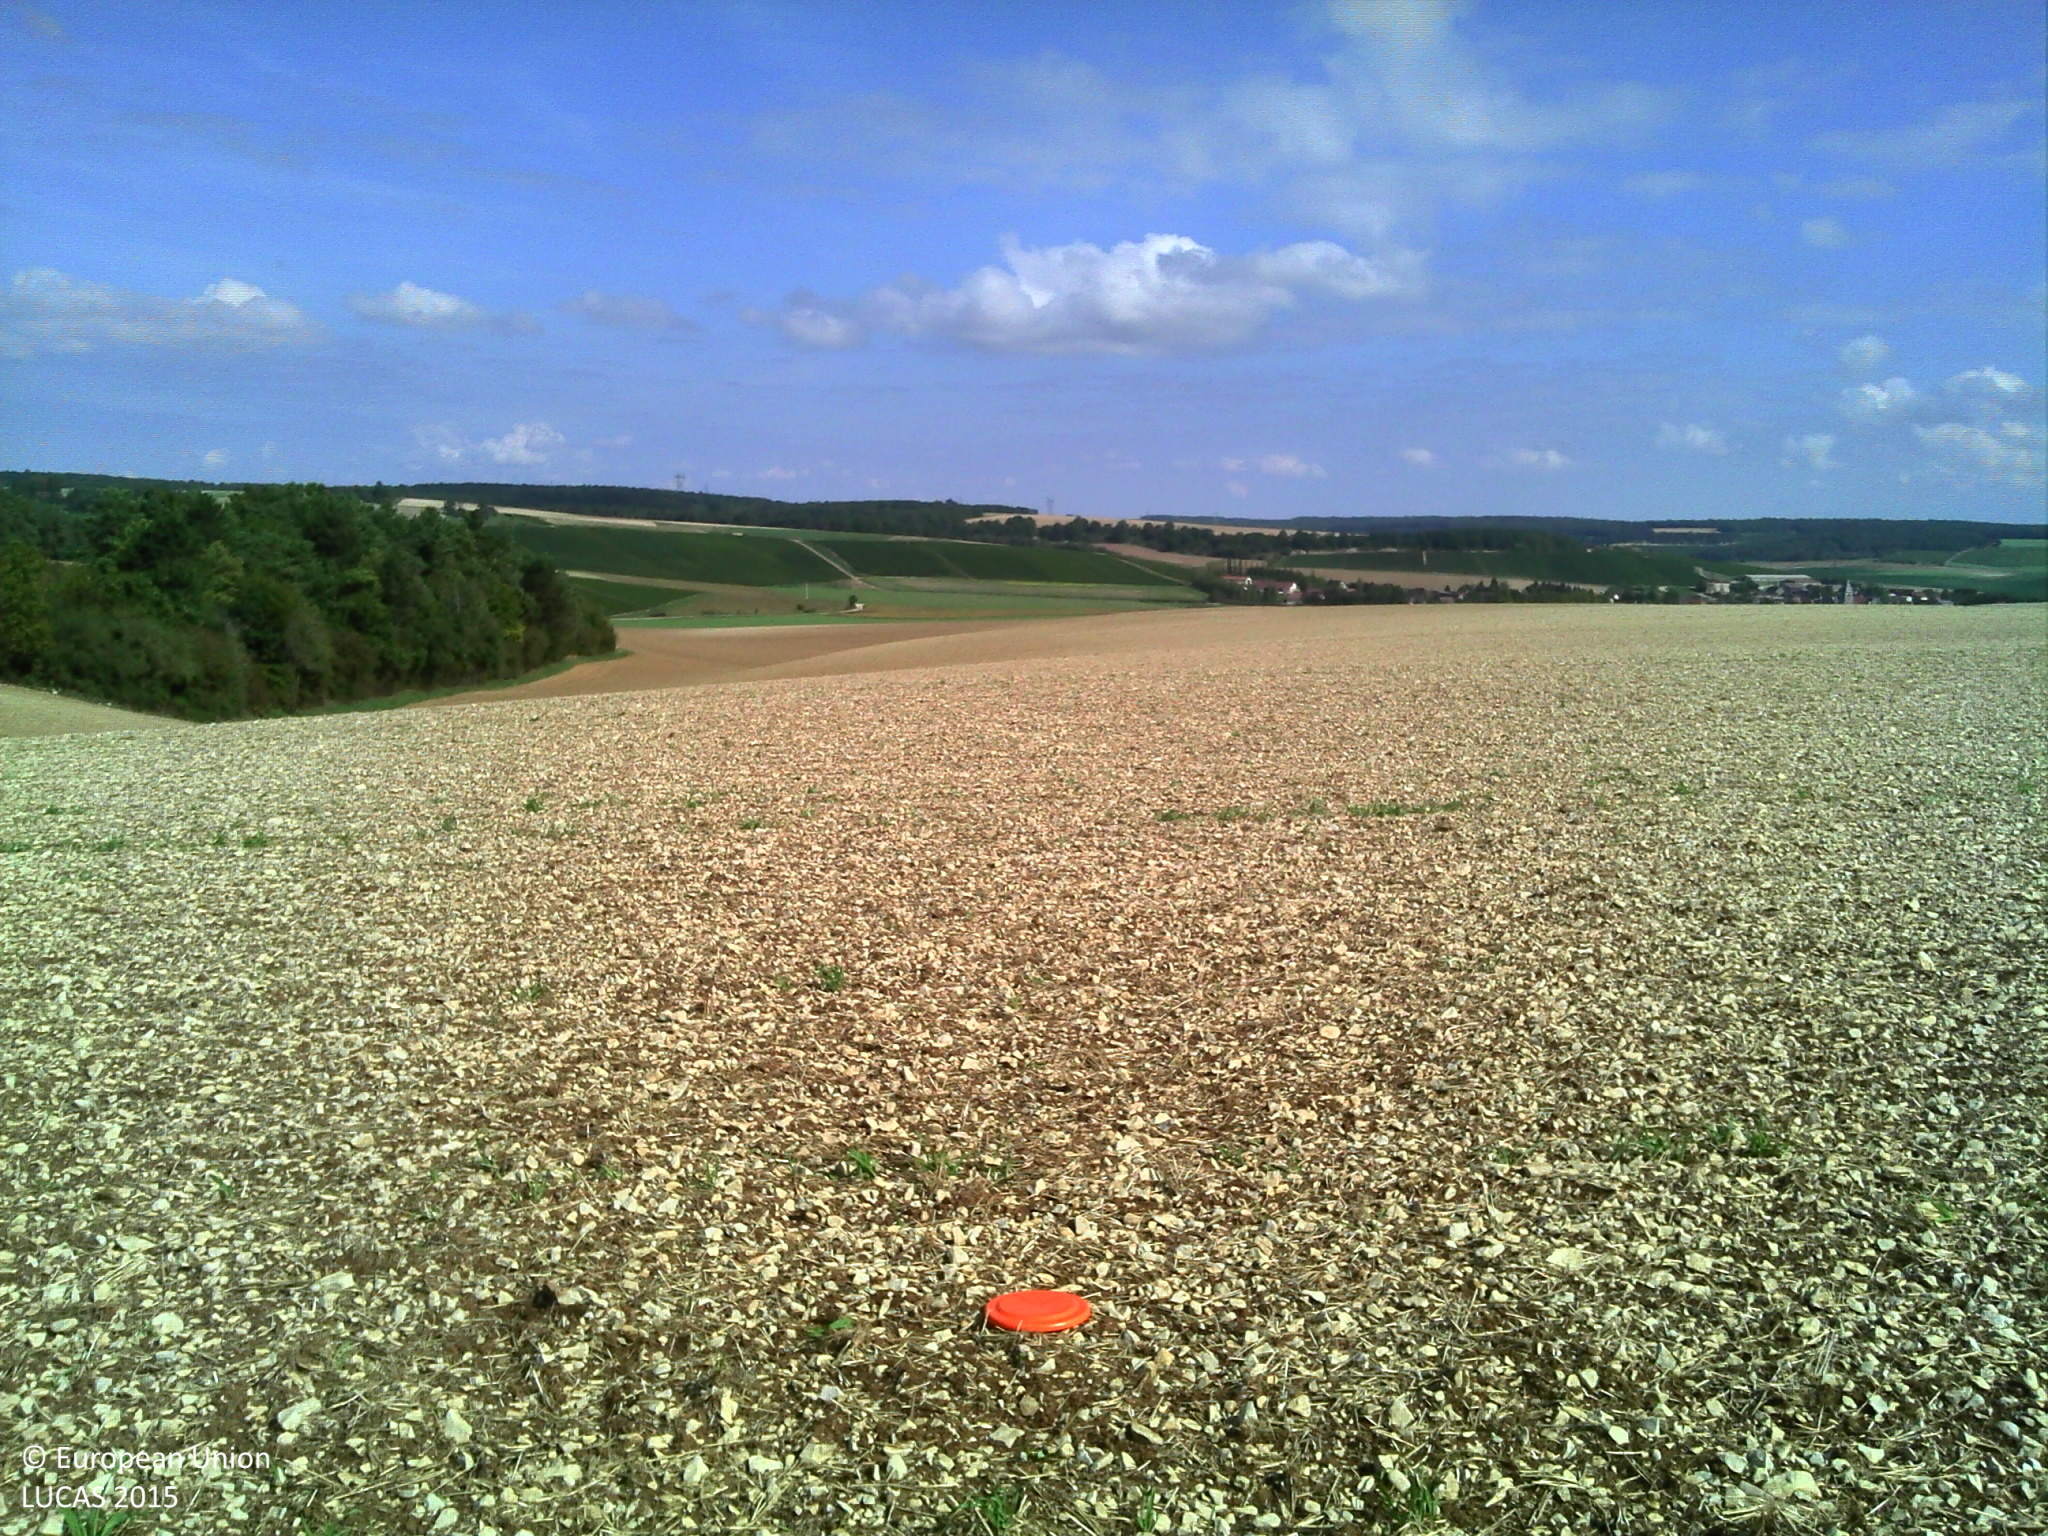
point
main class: Cropland
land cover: Barley
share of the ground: < 10 %
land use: Agriculture (excluding fallow land and kitchen gardens)
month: September
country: FR
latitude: 47.9847
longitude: 4.2763
